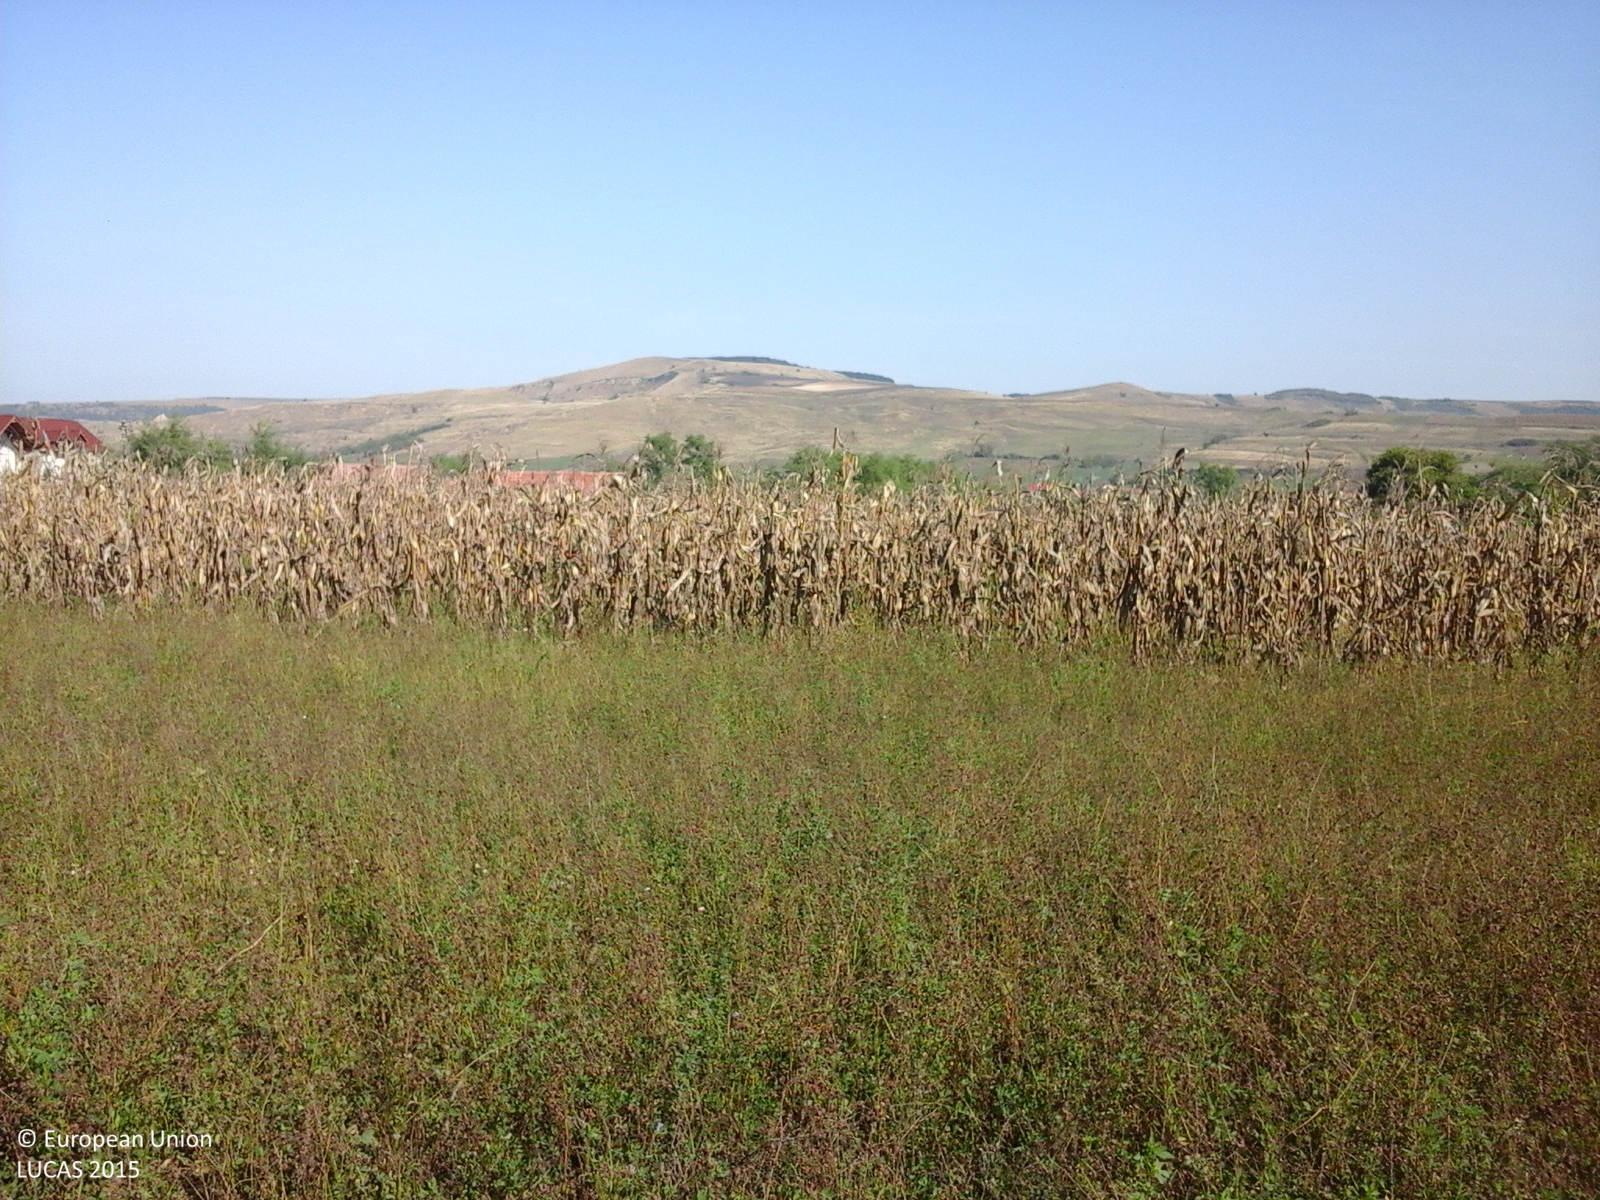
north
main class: Cropland
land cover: Lucerne
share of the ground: > 75 %
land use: Agriculture (excluding fallow land and kitchen gardens)
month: October
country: RO
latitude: 46.0673
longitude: 23.8394
